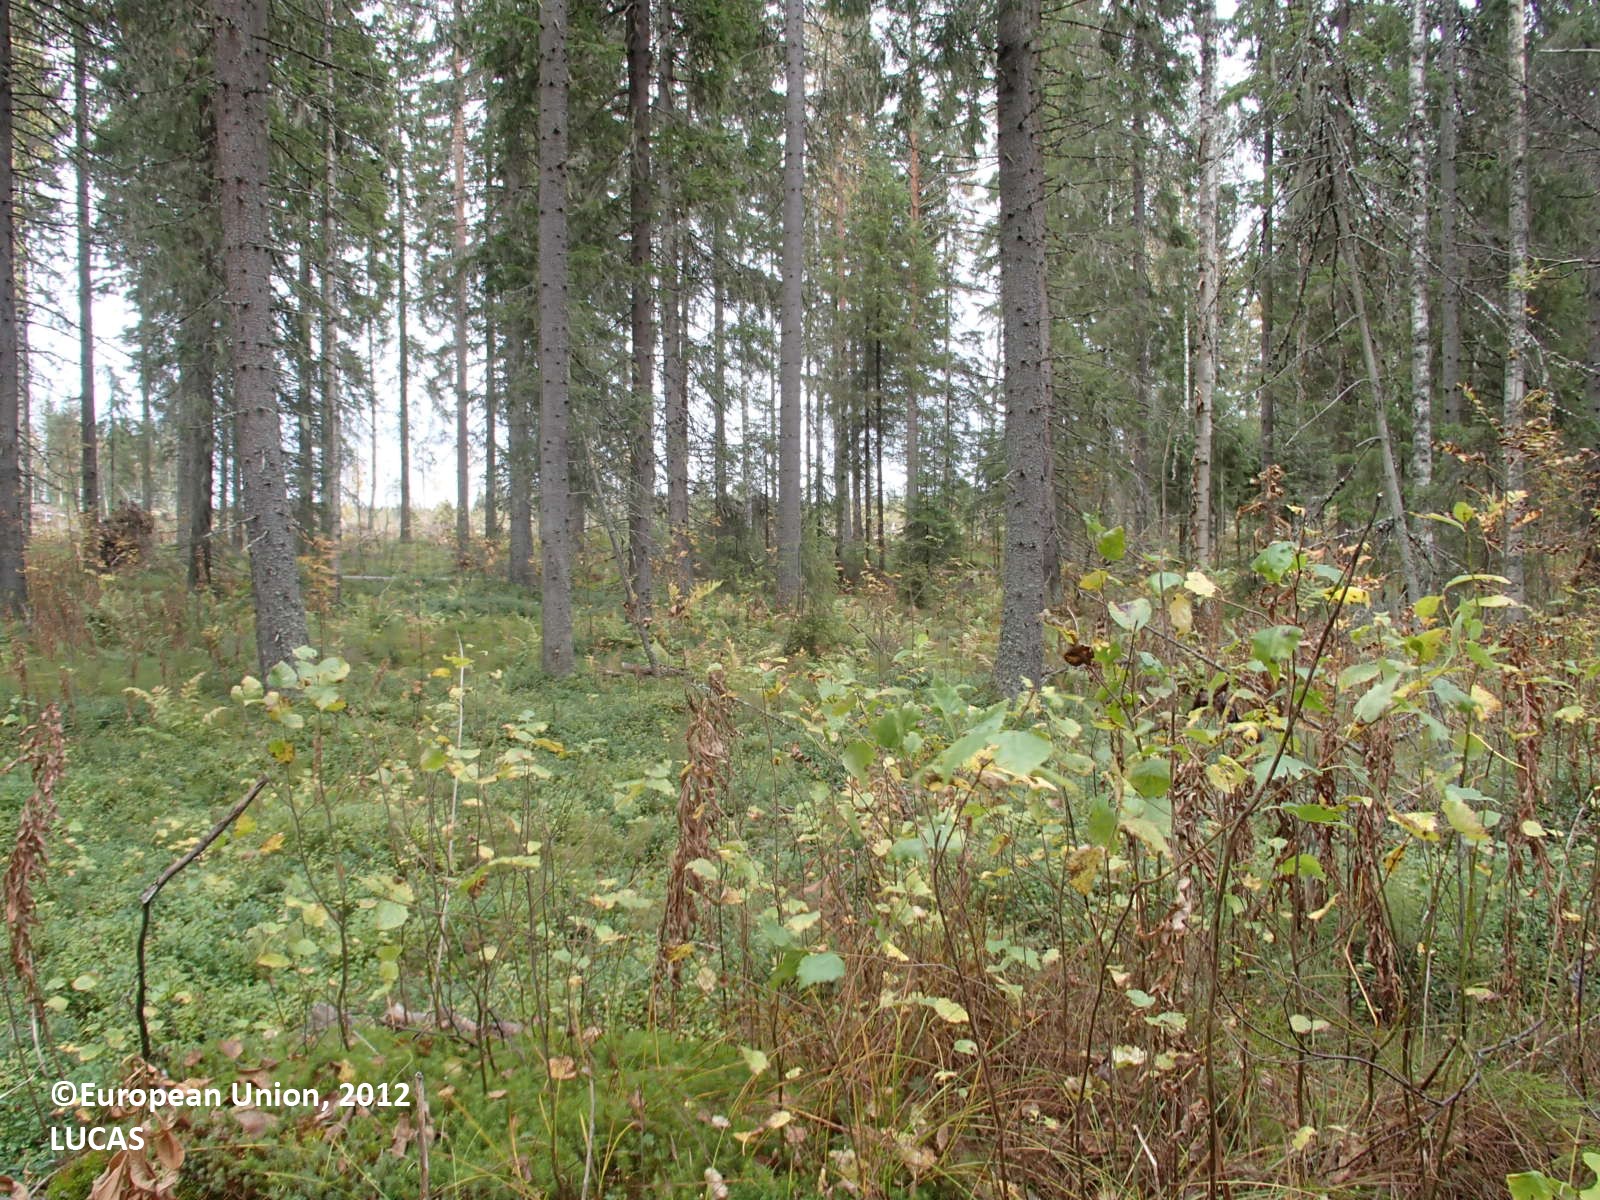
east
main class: Woodland
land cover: Spruce dominated coniferous woodland
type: boreal forest
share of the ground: 50 - 75 %
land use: Forestry
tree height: > 5 m
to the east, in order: Spruce dominated coniferous woodland; Pine dominated coniferous woodland; Ditches and canals; Pine dominated coniferous woodland; Ditches and canals; Pine dominated coniferous woodland; Ditches and canals; Pine dominated coniferous woodland; Ditches and canals; Pine dominated coniferous woodland; Other bare soil; Ditches and canals; Pine dominated coniferous woodland; Pine dominated mixed woodland
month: September
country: FI
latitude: 63.5387
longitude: 26.0247
